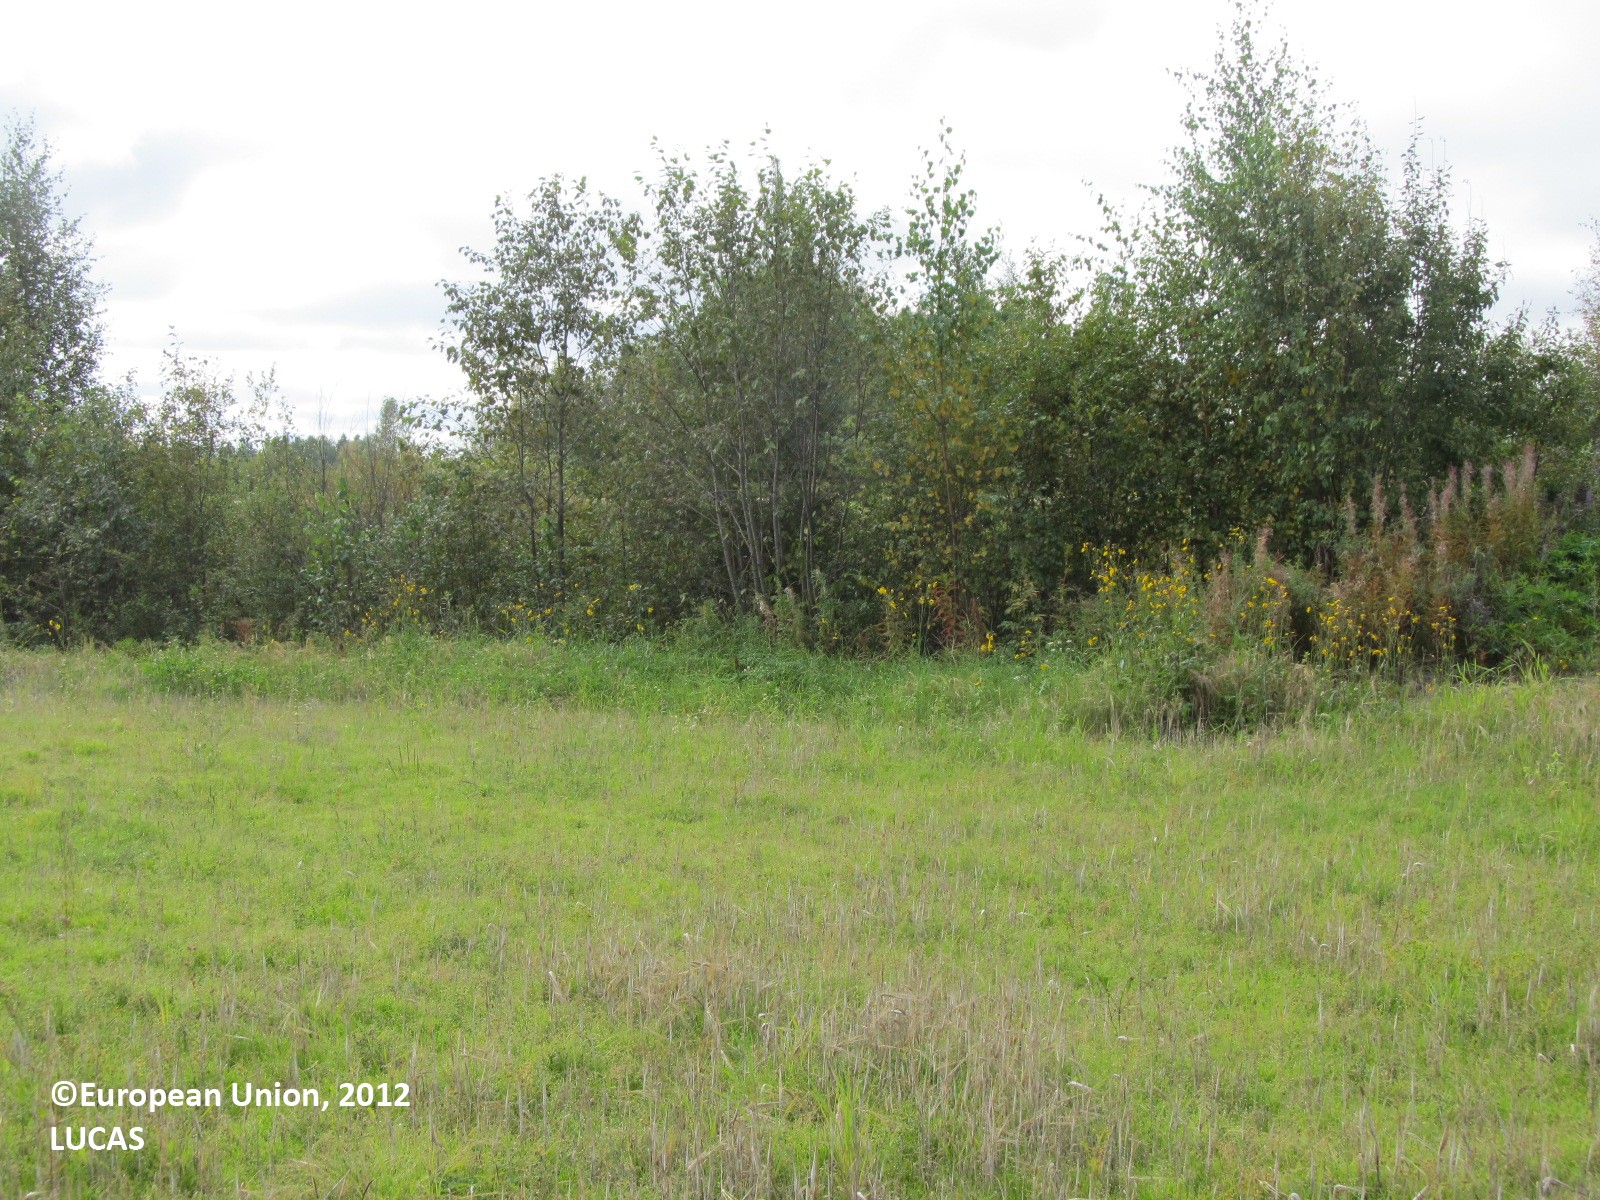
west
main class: Cropland
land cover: Barley
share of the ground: 25 - 50 %
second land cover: Grassland without tree/shrub cover
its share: 50 - 75 %
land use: Agriculture (excluding fallow land and kitchen gardens)
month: September
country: FI
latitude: 62.9376
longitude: 28.2130
